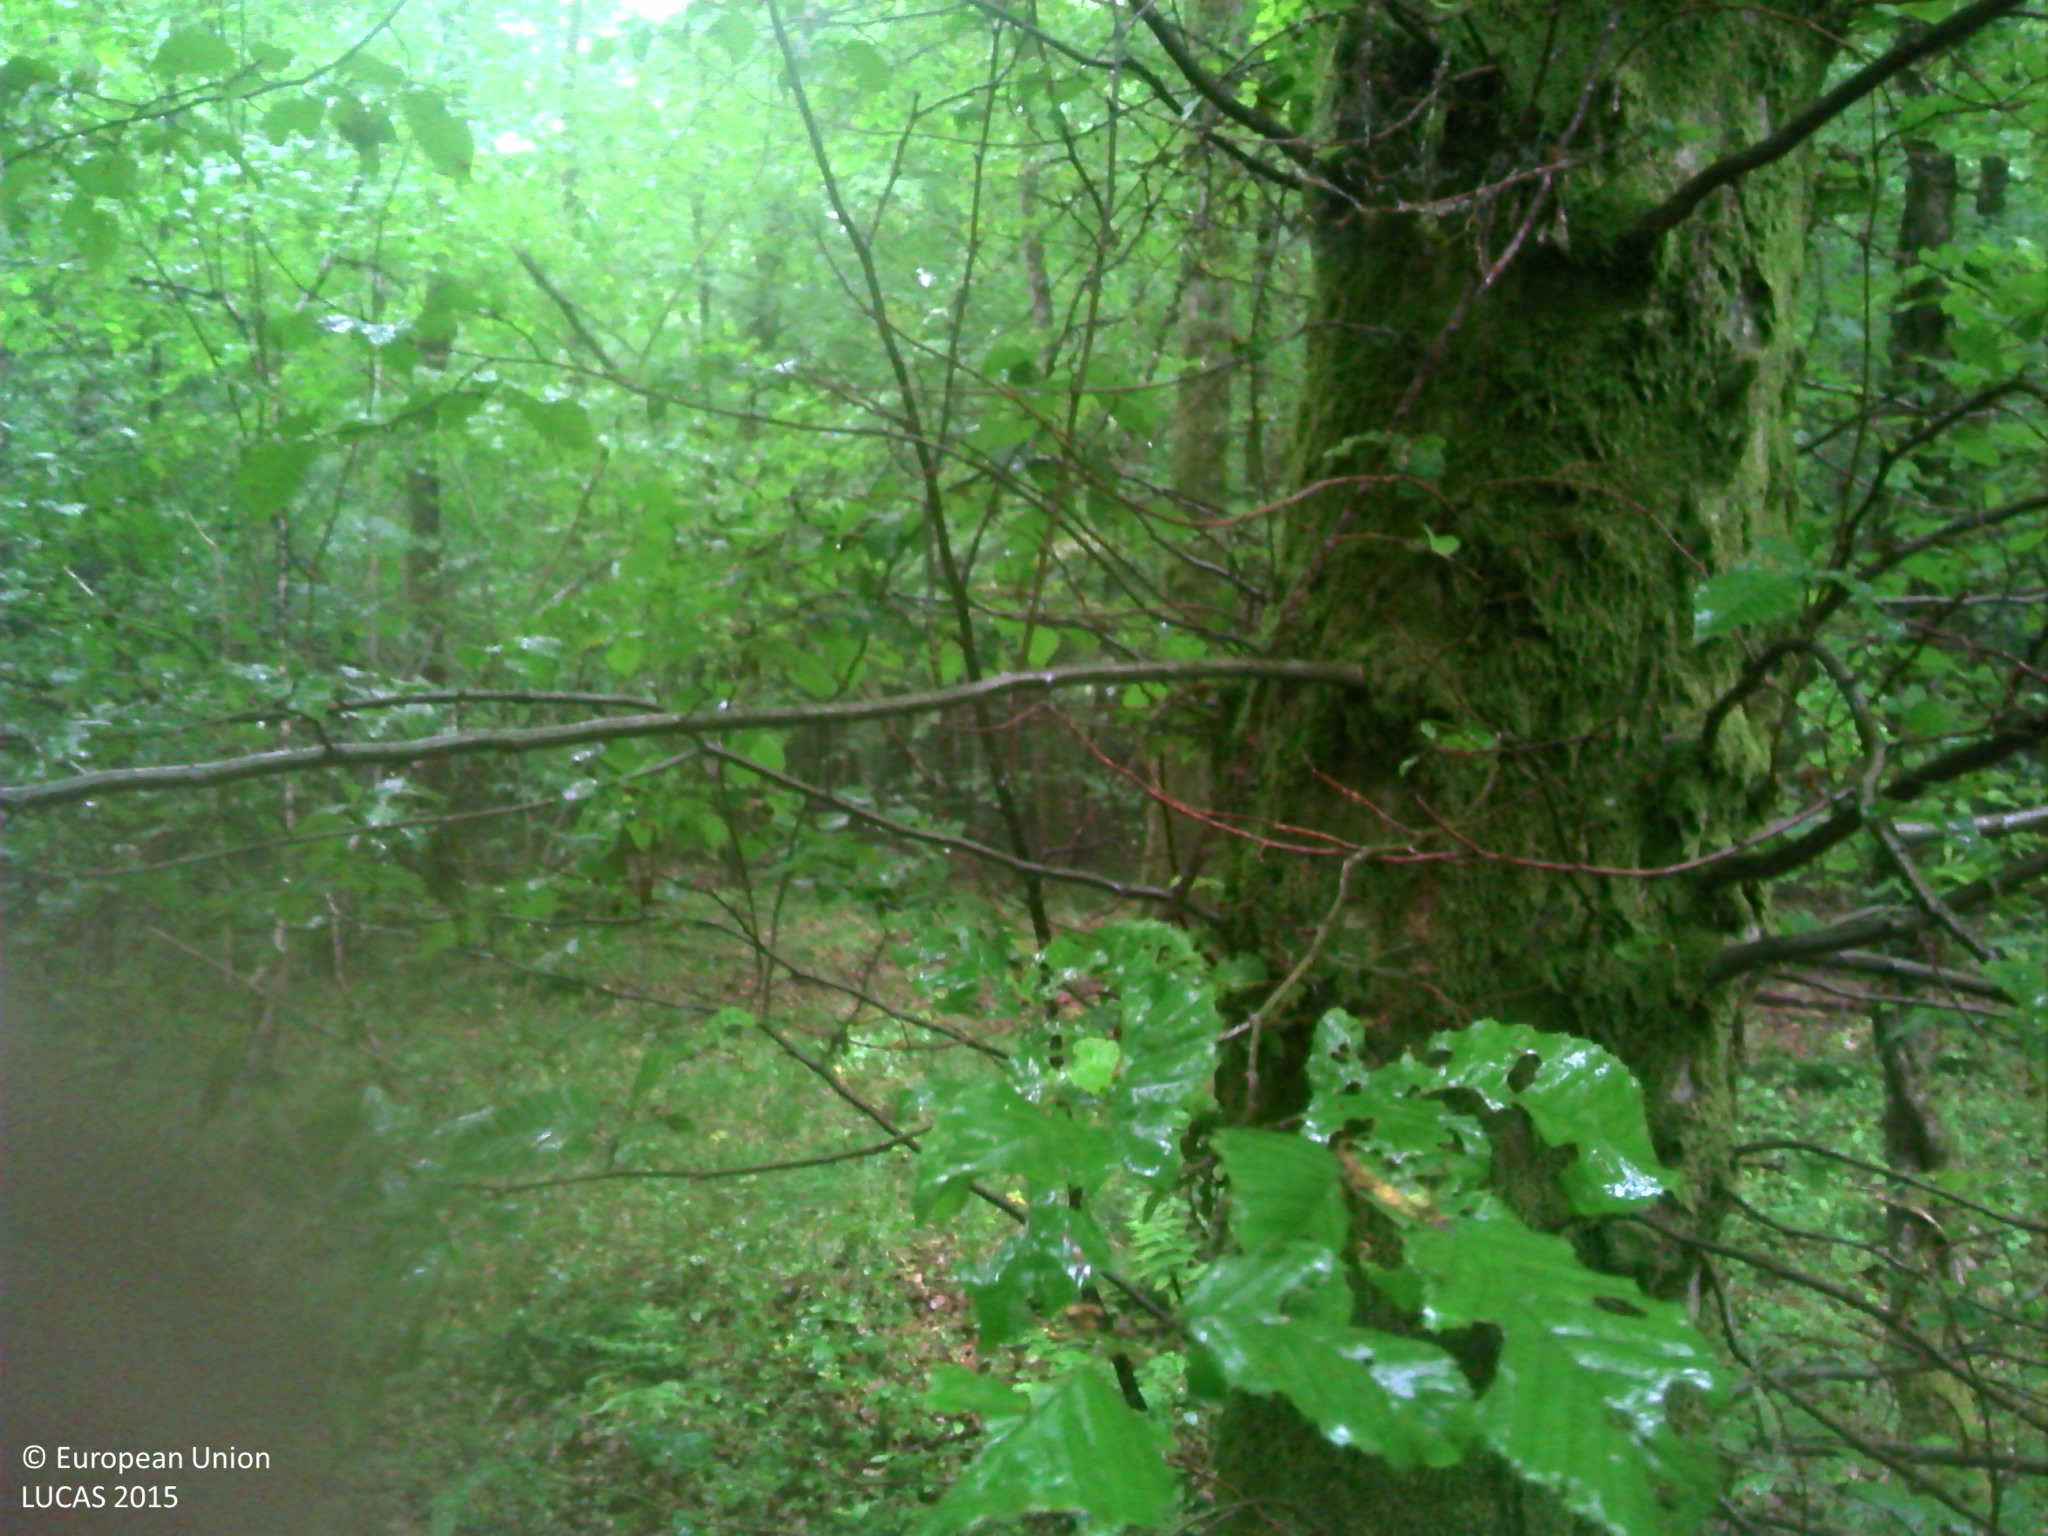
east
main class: Woodland
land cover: Broadleaved woodland
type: mesophytic deciduous forest
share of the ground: > 75 %
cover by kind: broadleaved forest trees 90 %, herbaceous plants 10 %
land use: Forestry
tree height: > 5 m
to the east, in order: Broadleaved woodland; Ditches and canals; Grass margins; Tracks; Broadleaved woodland; Tracks; Broadleaved woodland
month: May
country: FR
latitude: 48.6121
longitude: 4.9389
